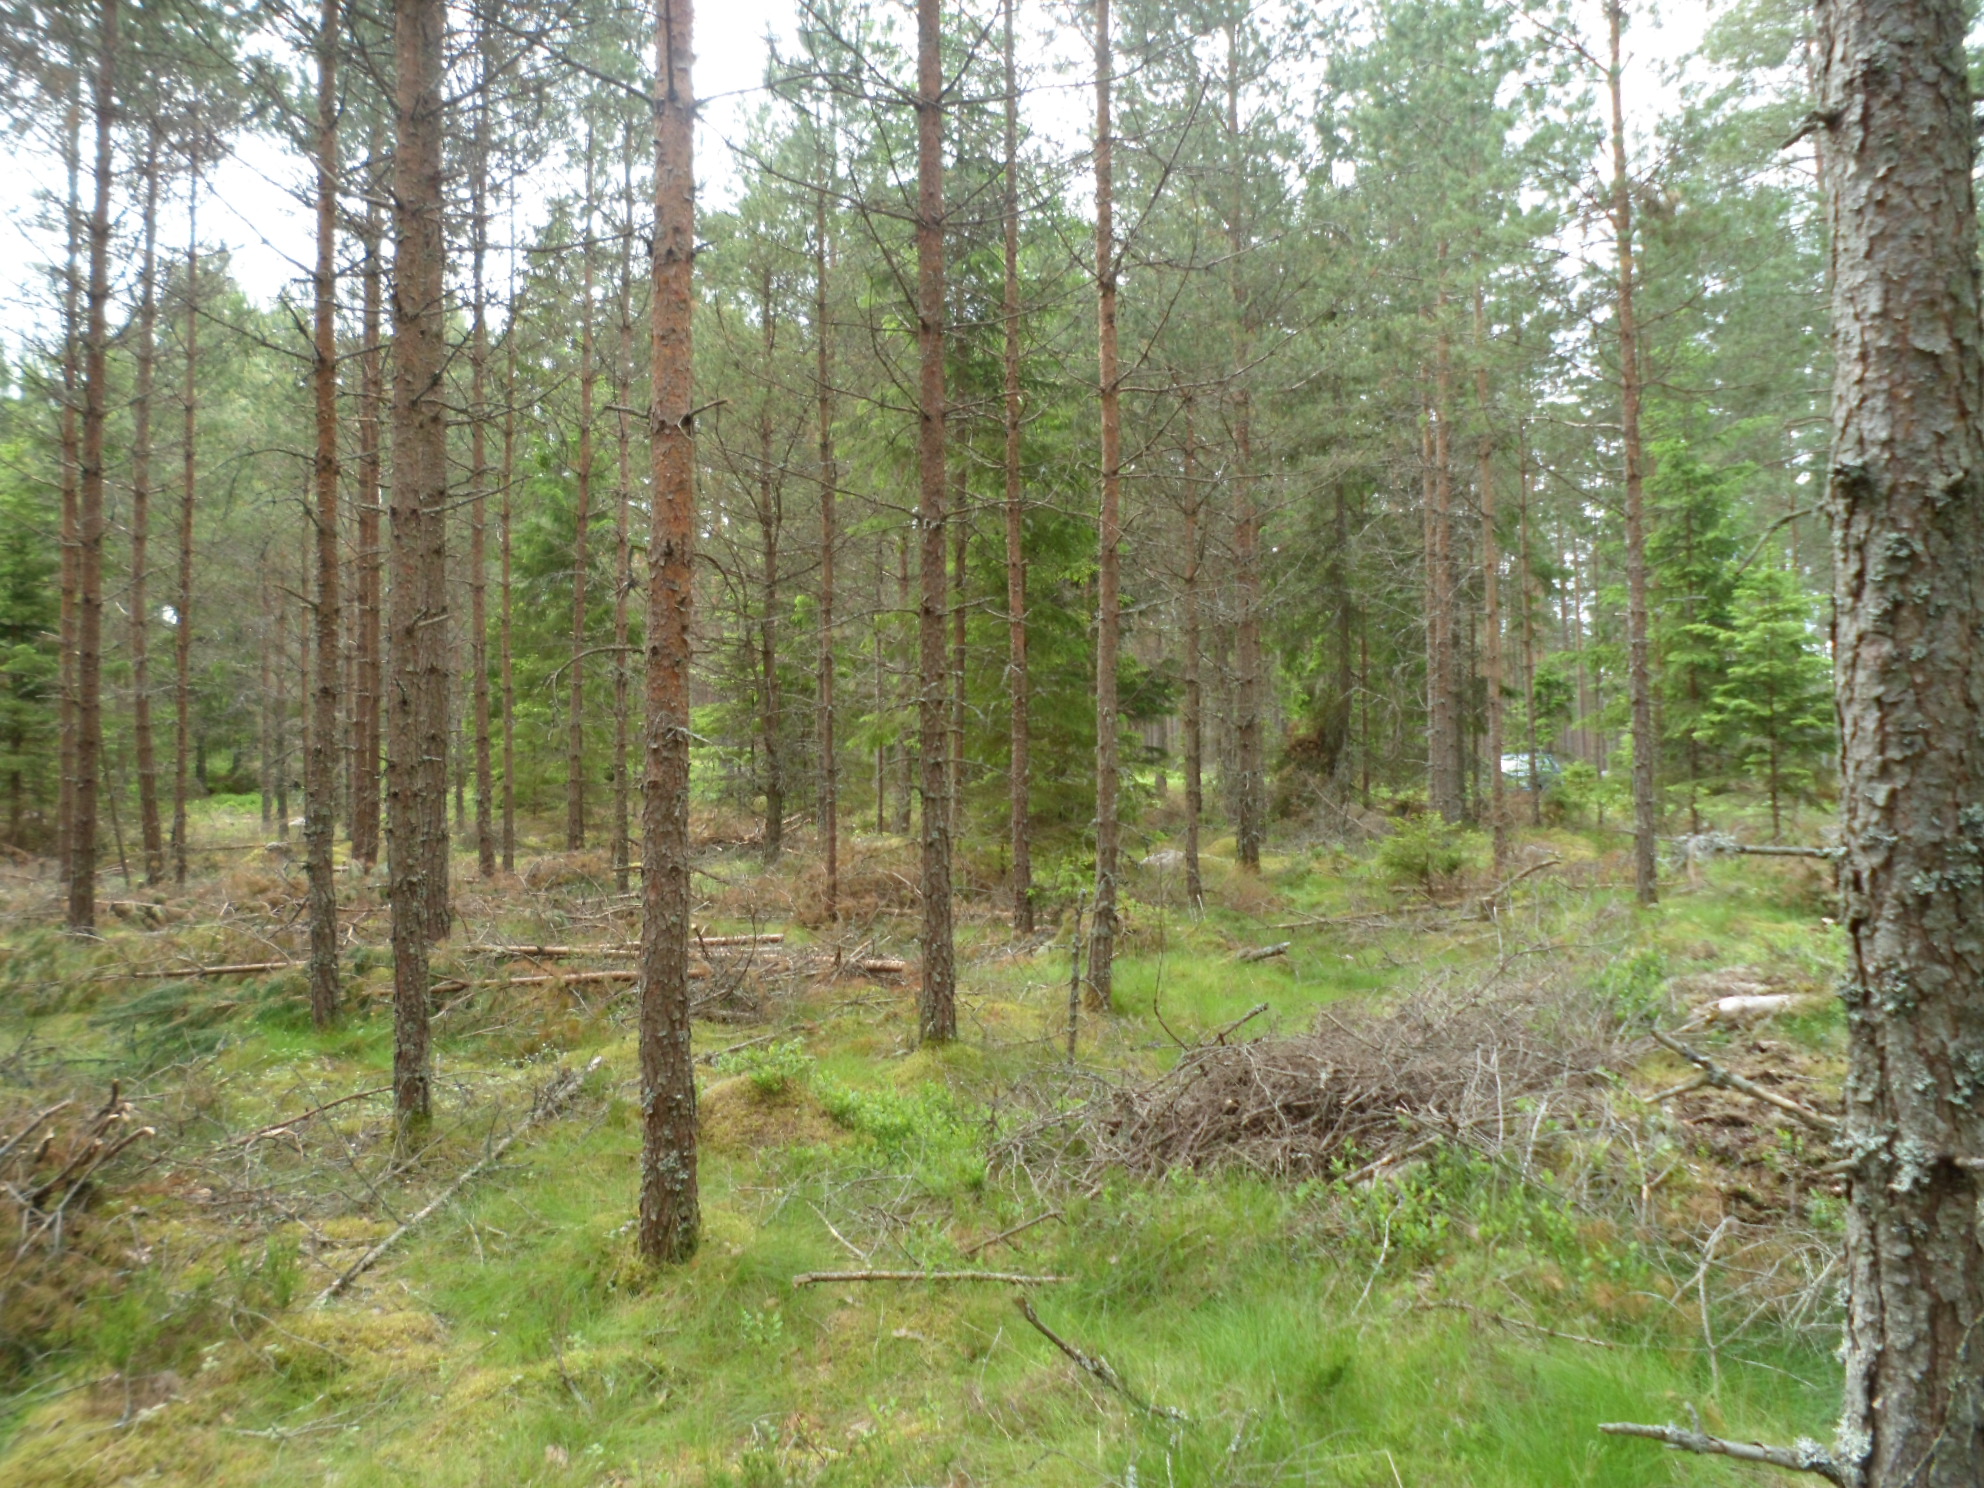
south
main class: Woodland
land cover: Pine dominated coniferous woodland
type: boreal forest
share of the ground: 50 - 75 %
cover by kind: coniferous forest trees 50 %, shrubs 20 %, lichens and mosses 20 %, herbaceous plants 10 %
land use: Forestry
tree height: > 5 m
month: June
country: SE
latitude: 56.9623
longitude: 15.2768
